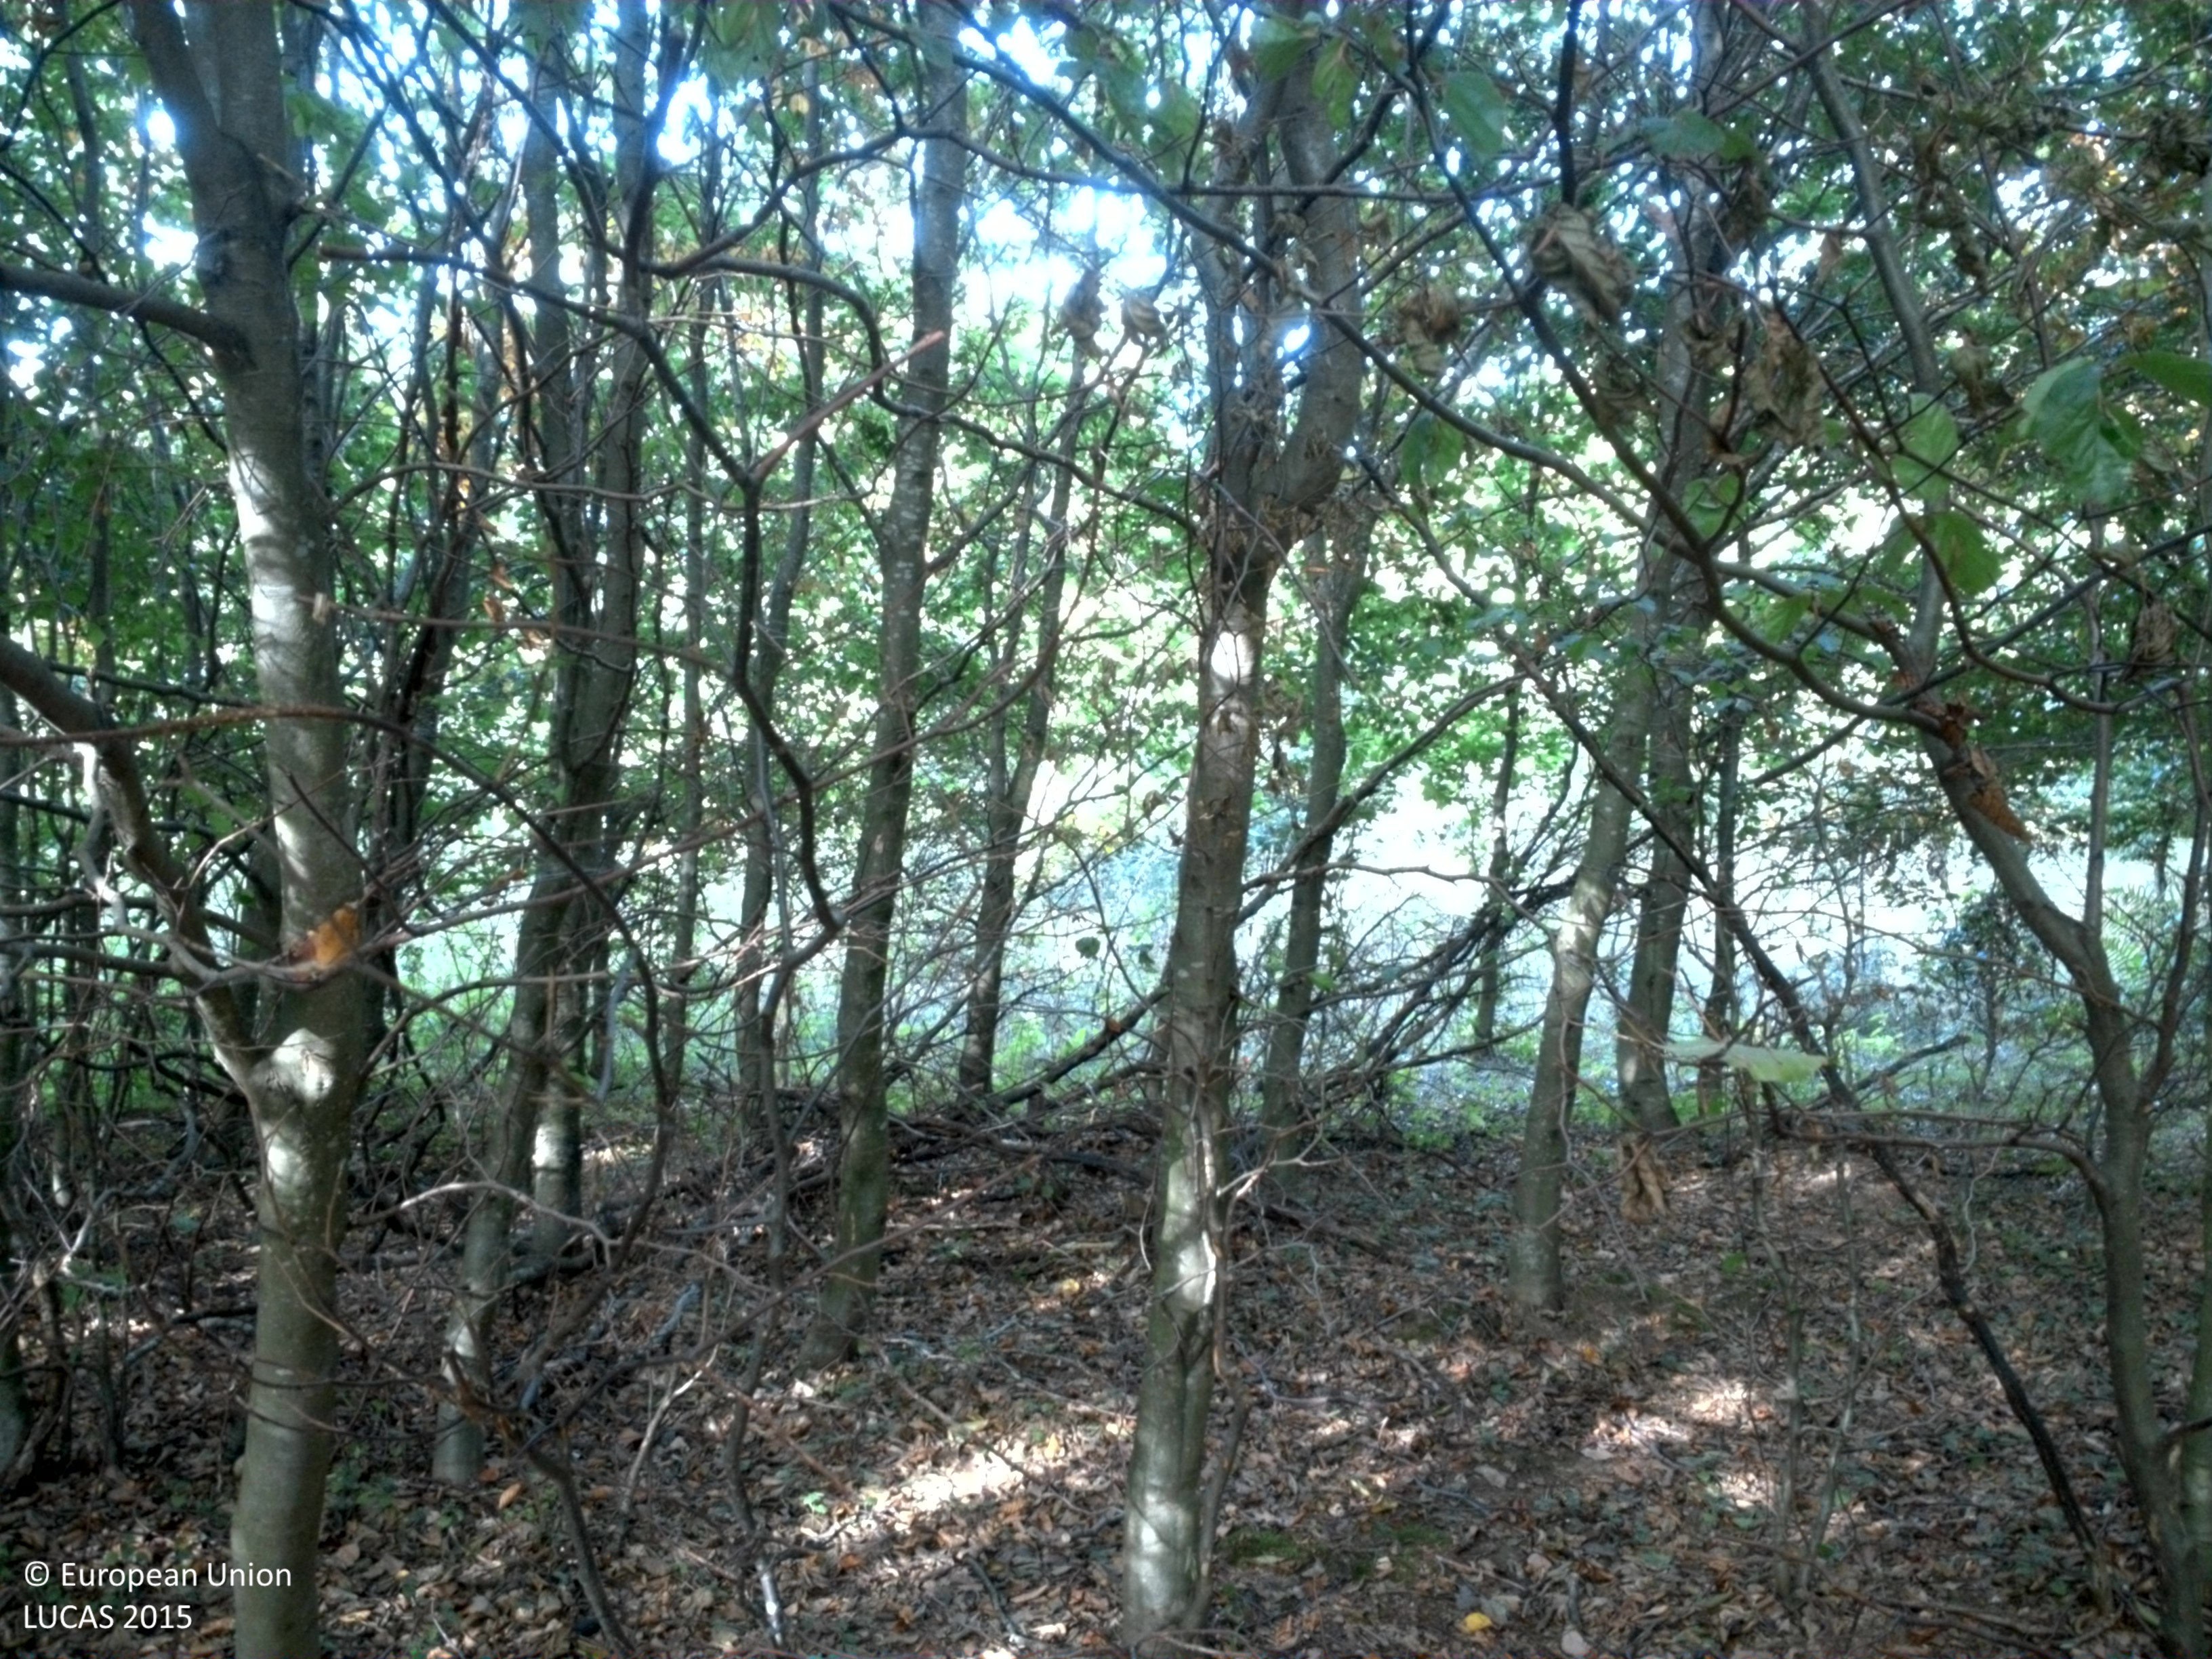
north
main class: Woodland
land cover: Broadleaved woodland
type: beech forest
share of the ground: > 75 %
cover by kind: broadleaved forest trees 90 %, herbaceous plants 5 %, unconsolidated bare surface 5 %
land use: Forestry
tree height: < 5 m
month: October
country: SE
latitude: 55.6854
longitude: 13.6723
